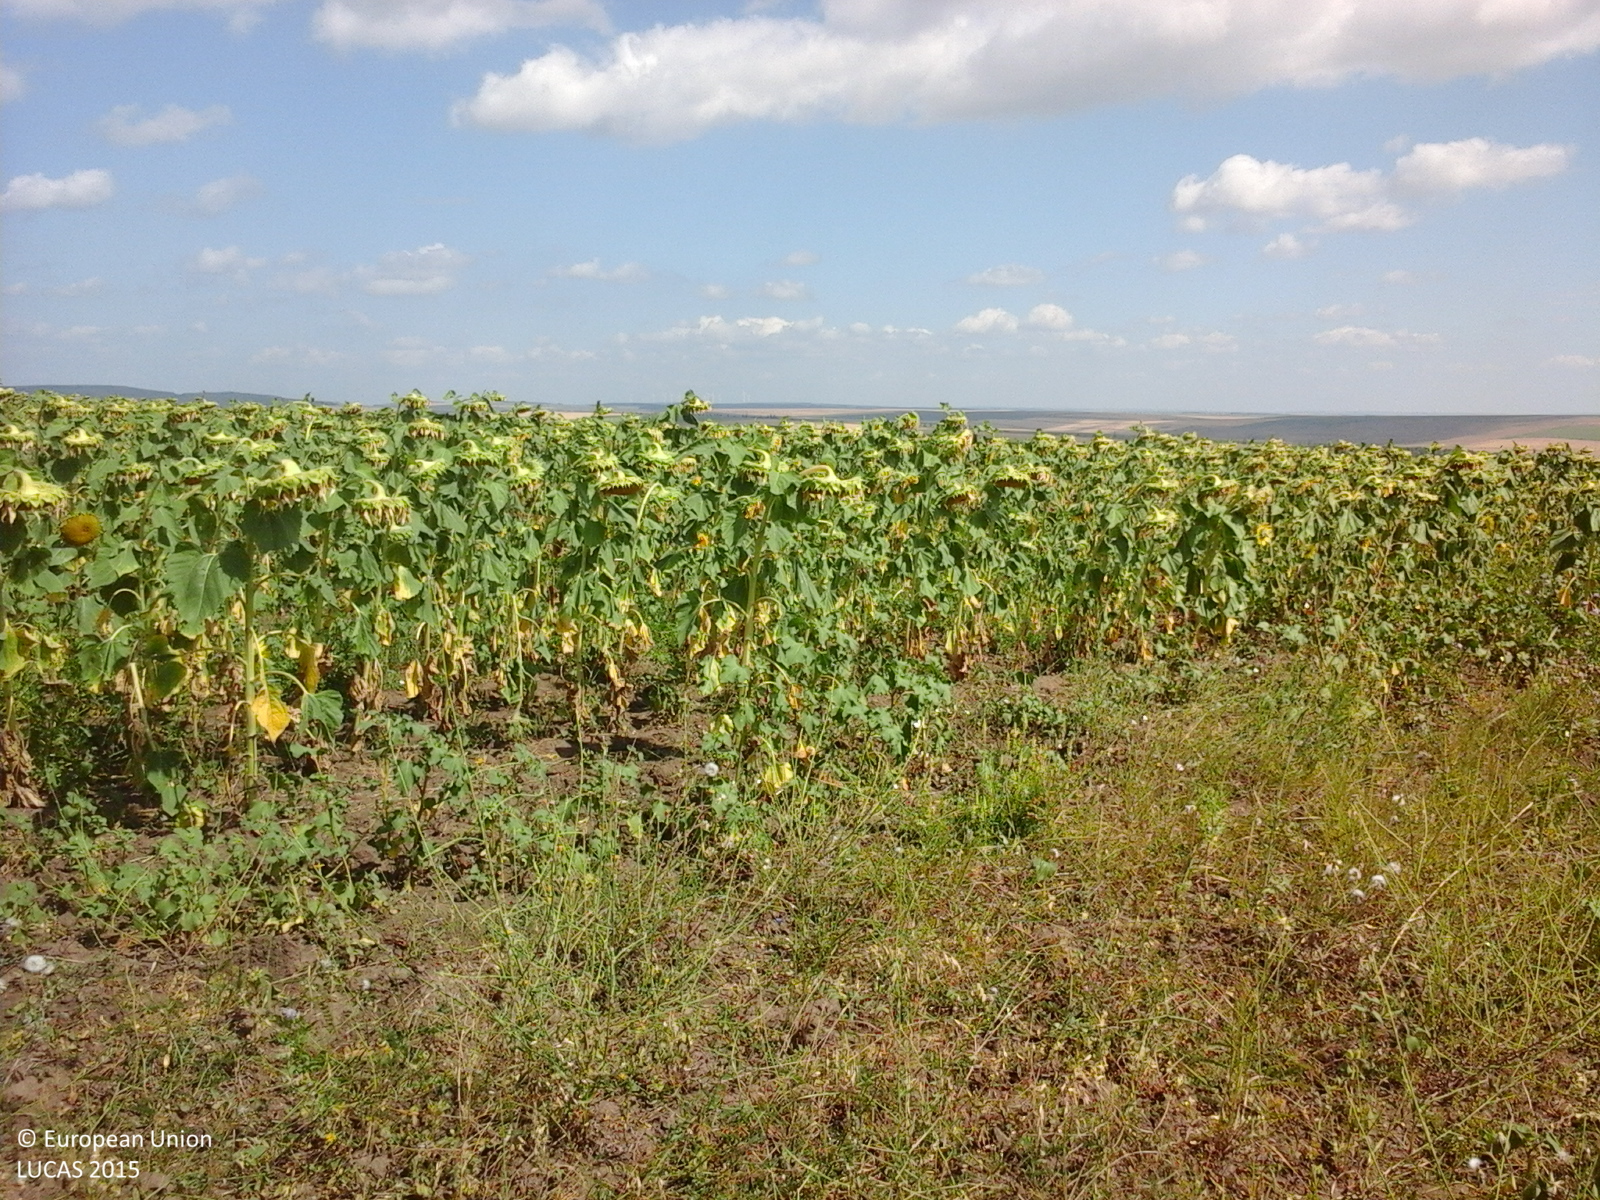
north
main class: Grassland
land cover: Spontaneously vegetated surfaces
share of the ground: > 75 %
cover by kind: herbaceous plants 100 %
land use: Fallow land
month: July
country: RO
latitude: 46.3312
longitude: 27.9323
